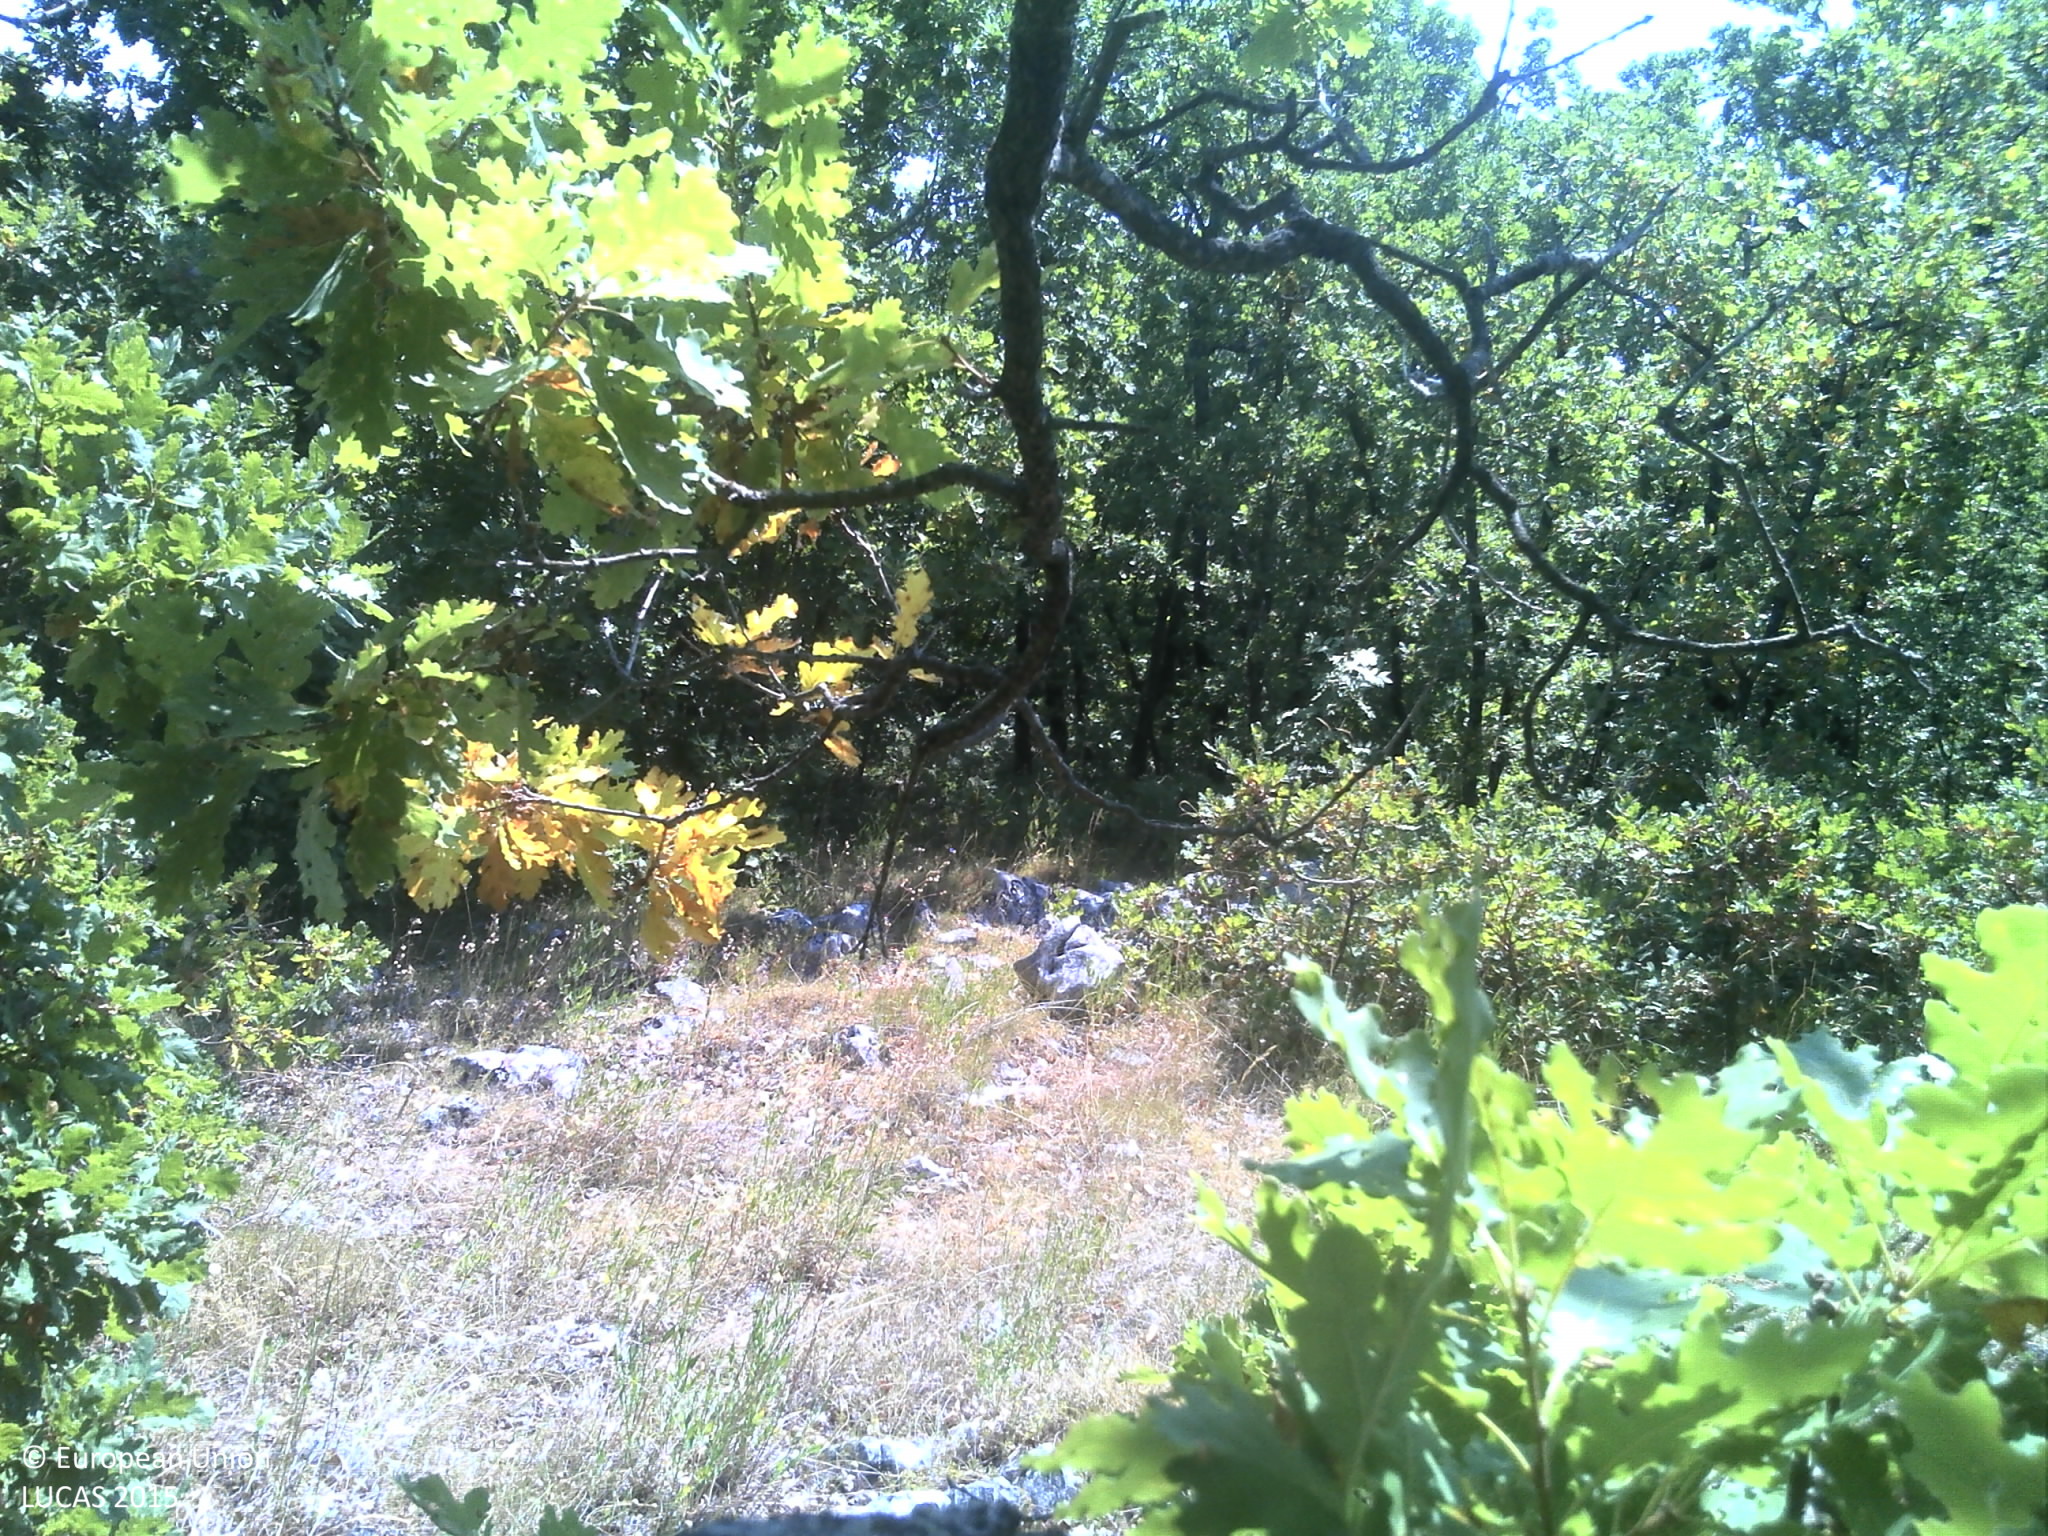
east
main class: Woodland
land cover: Broadleaved woodland
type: thermophilous deciduous forest
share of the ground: > 75 %
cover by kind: broadleaved forest trees 70 %, shrubs 10 %, herbaceous plants 5 %, lichens and mosses 5 %, consolidated bare surface 5 %, unconsolidated bare surface 5 %
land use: Semi-natural and natural areas not in use
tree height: > 5 m
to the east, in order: Broadleaved woodland; Shrubland with sparse tree cover; Dry stone walls; Grassland with sparse tree/shrub cover; Electric lines; Broadleaved woodland; Dry stone walls; Grassland with sparse tree/shrub cover; Dry stone walls; Broadleaved woodland
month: July
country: HR
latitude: 43.4632
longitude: 17.2474
